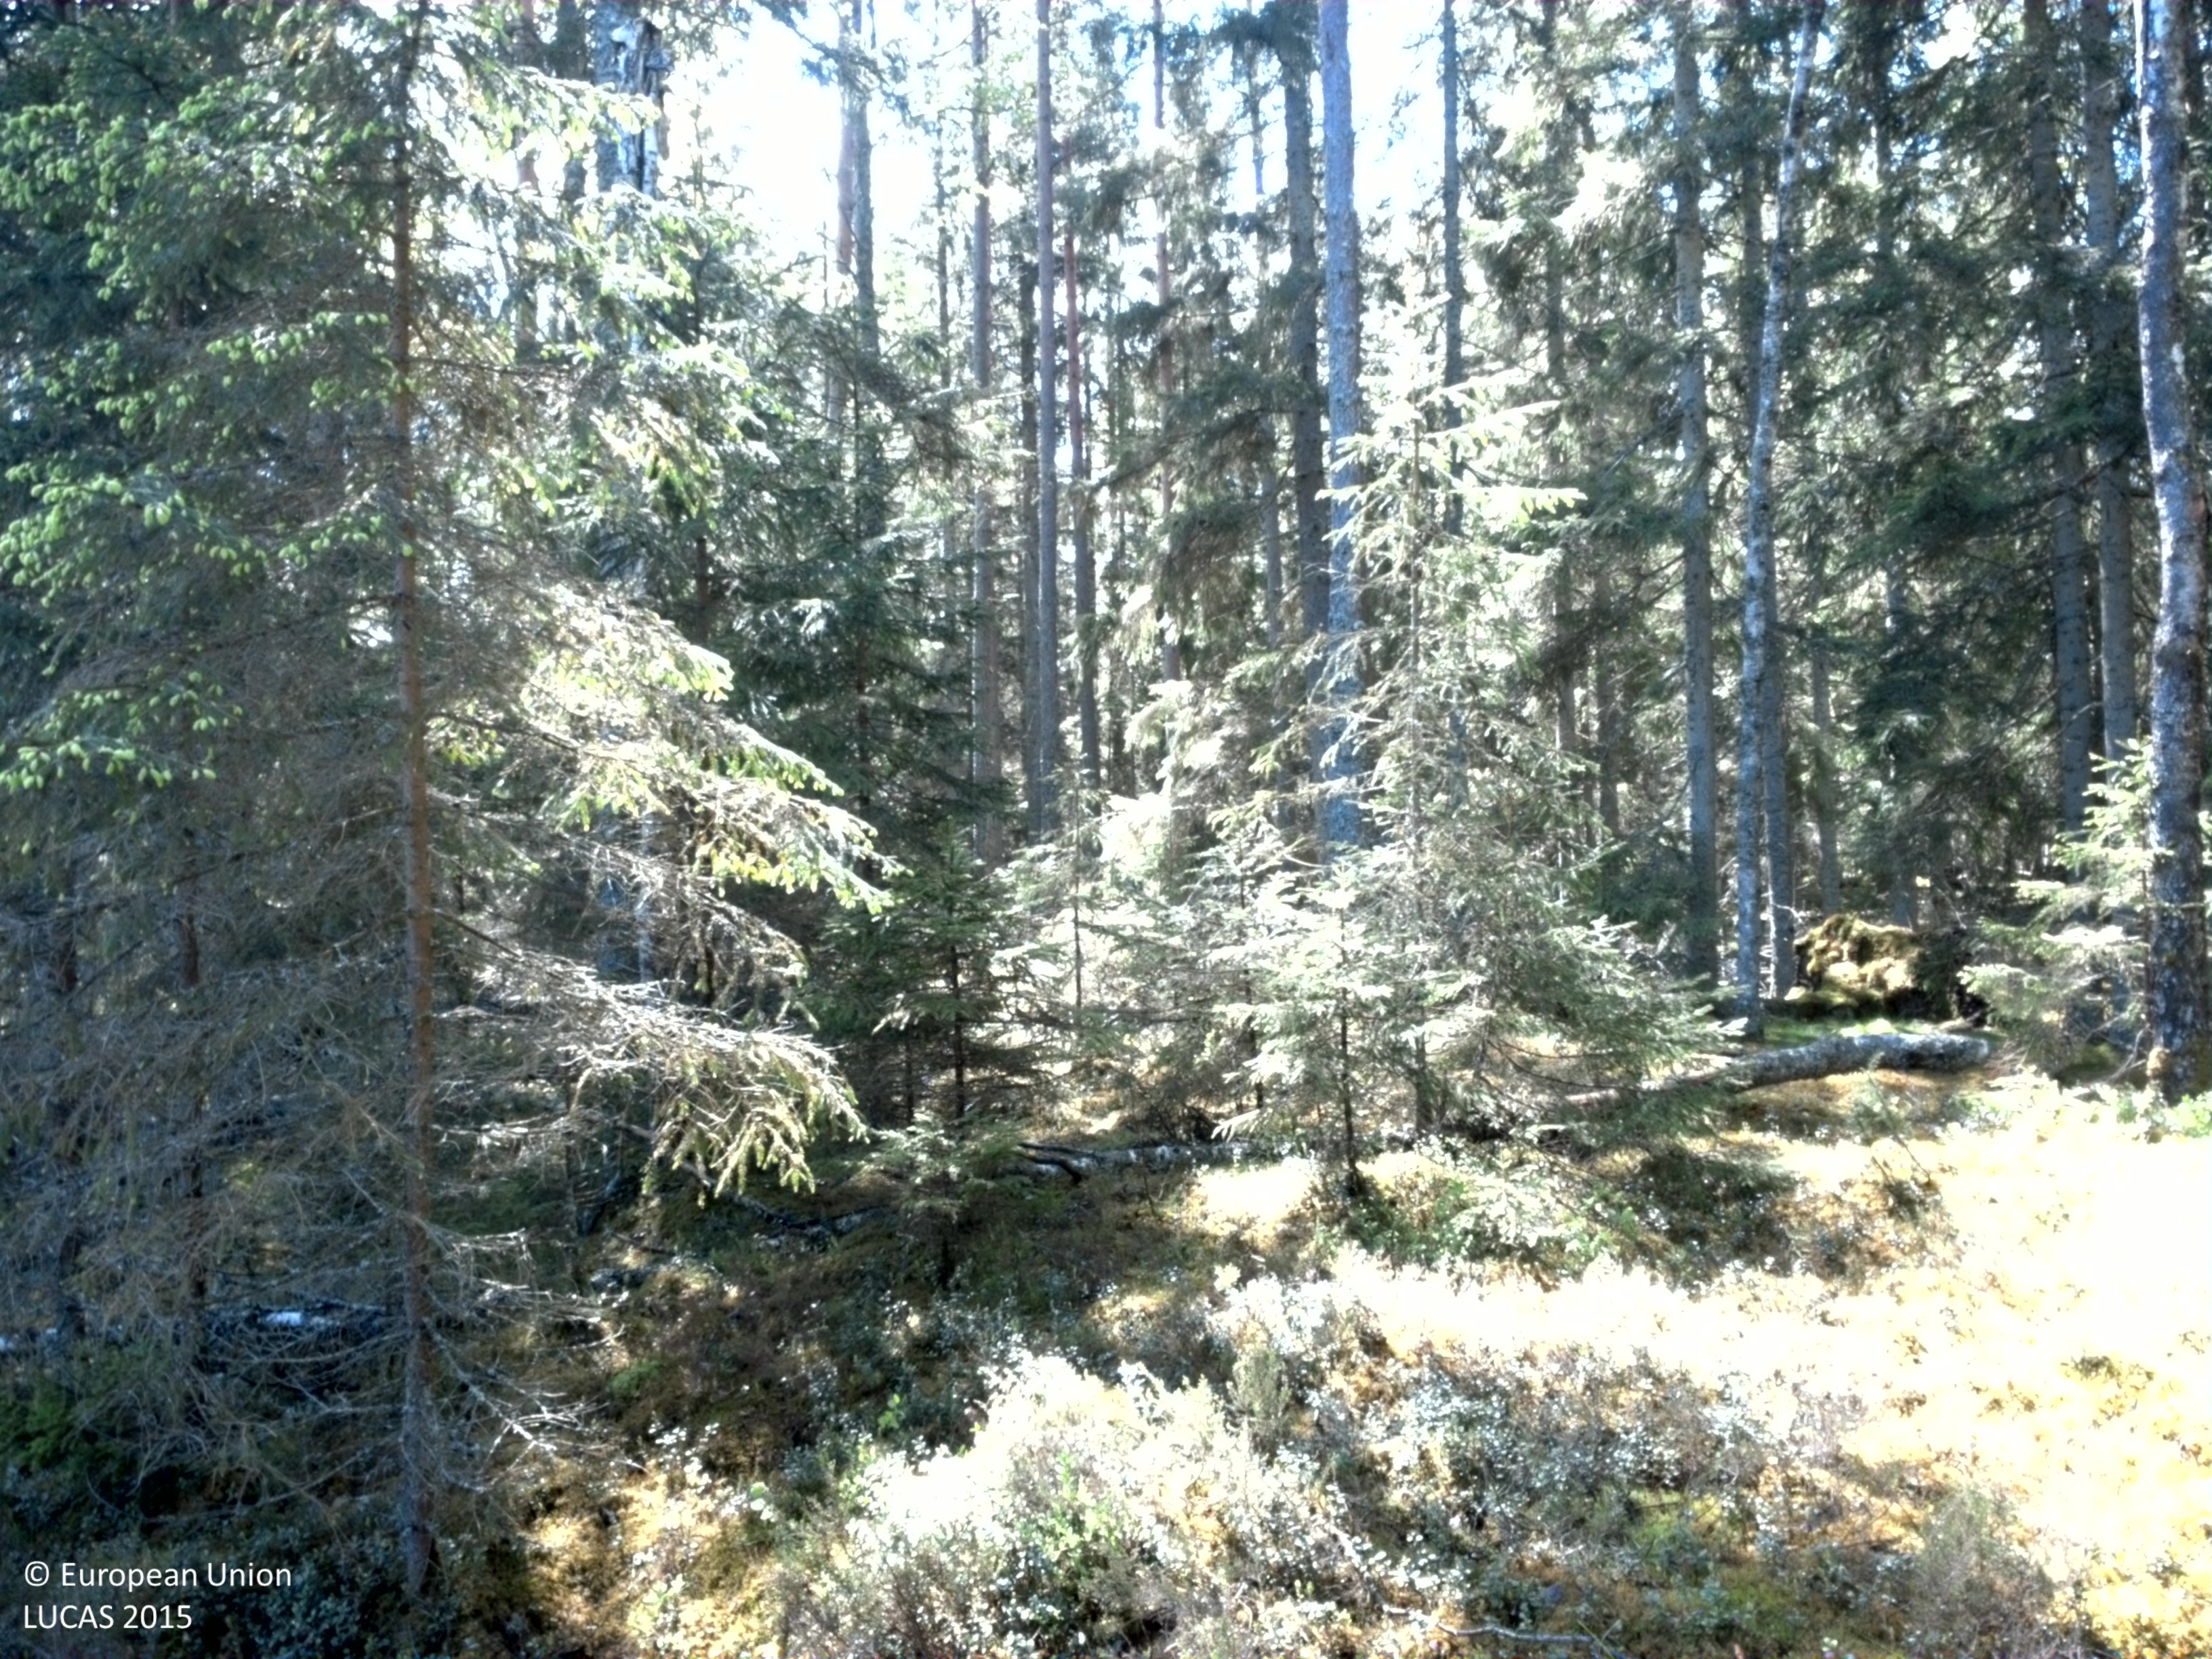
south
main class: Woodland
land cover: Spruce dominated coniferous woodland
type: boreal forest
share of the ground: 50 - 75 %
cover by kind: coniferous forest trees 45 %, lichens and mosses 30 %, broadleaved forest trees 10 %, shrubs 10 %, herbaceous plants 5 %
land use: Forestry
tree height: > 5 m
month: May
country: SE
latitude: 56.8977
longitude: 15.5310
